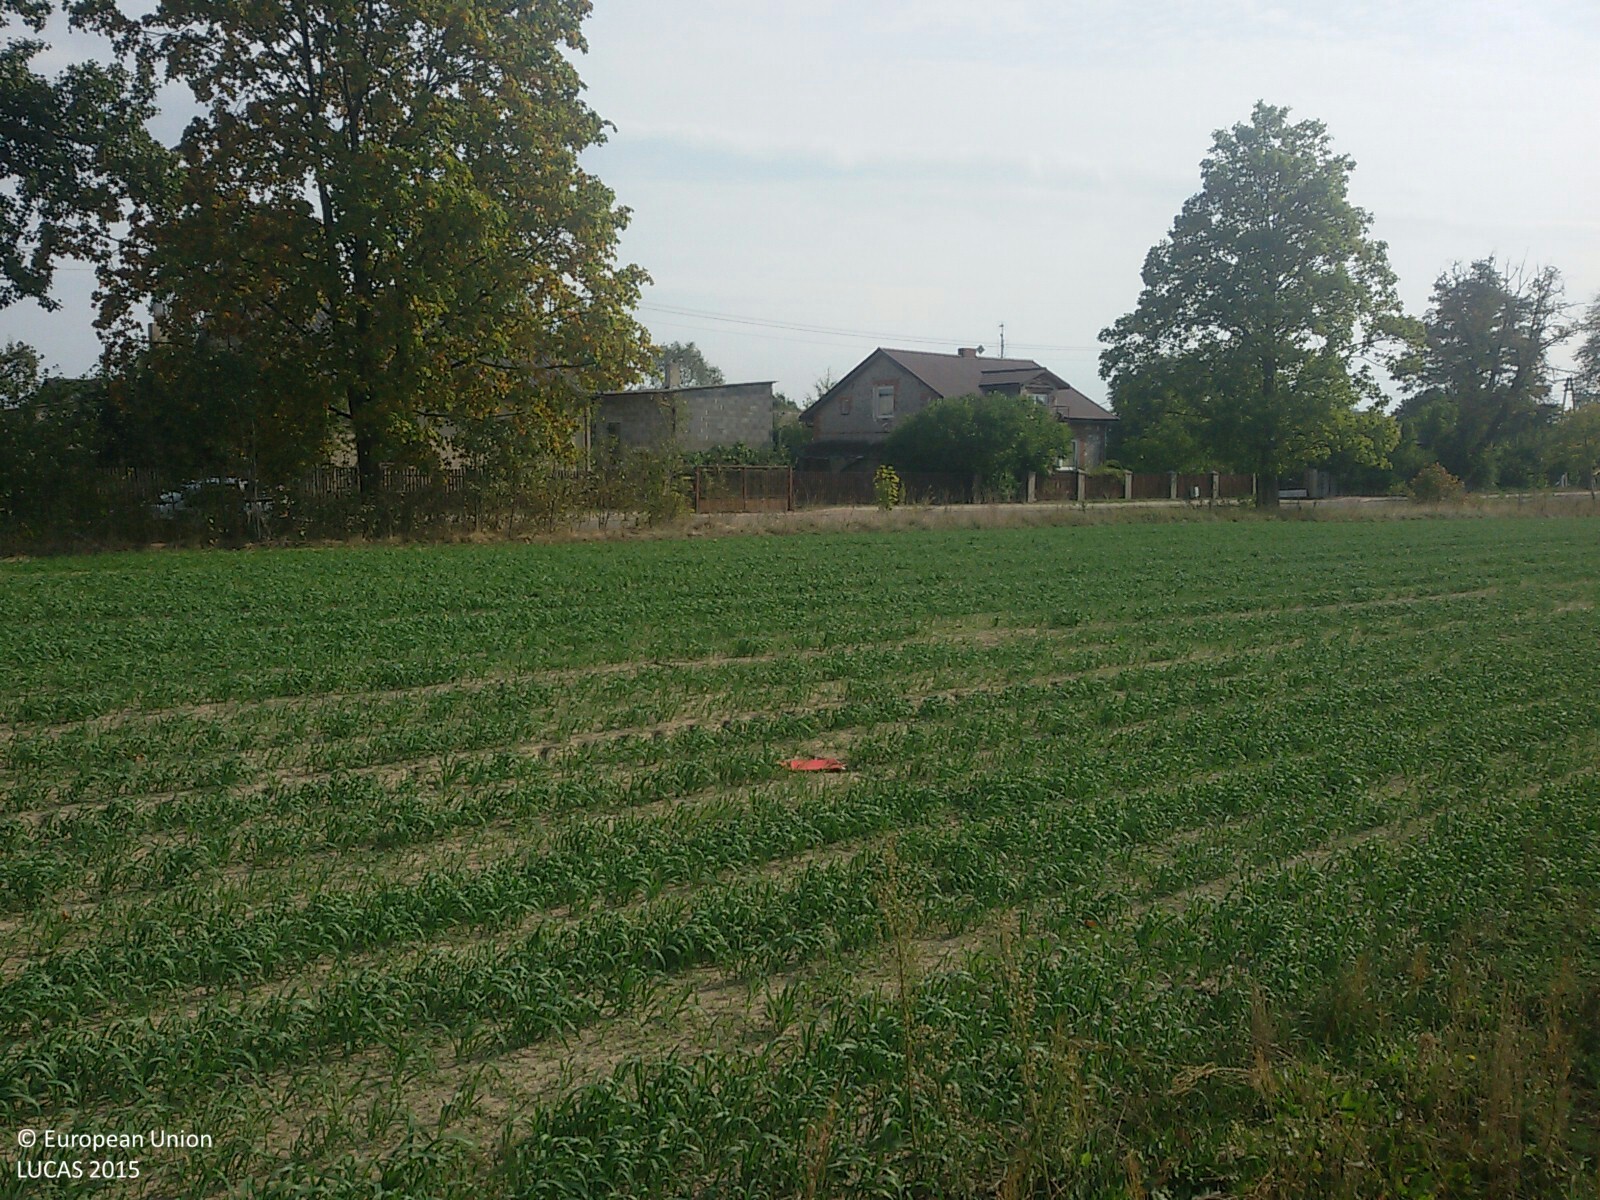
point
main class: Cropland
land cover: Oats
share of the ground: > 75 %
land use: Agriculture (excluding fallow land and kitchen gardens)
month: September
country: PL
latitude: 51.2518
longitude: 18.8335
